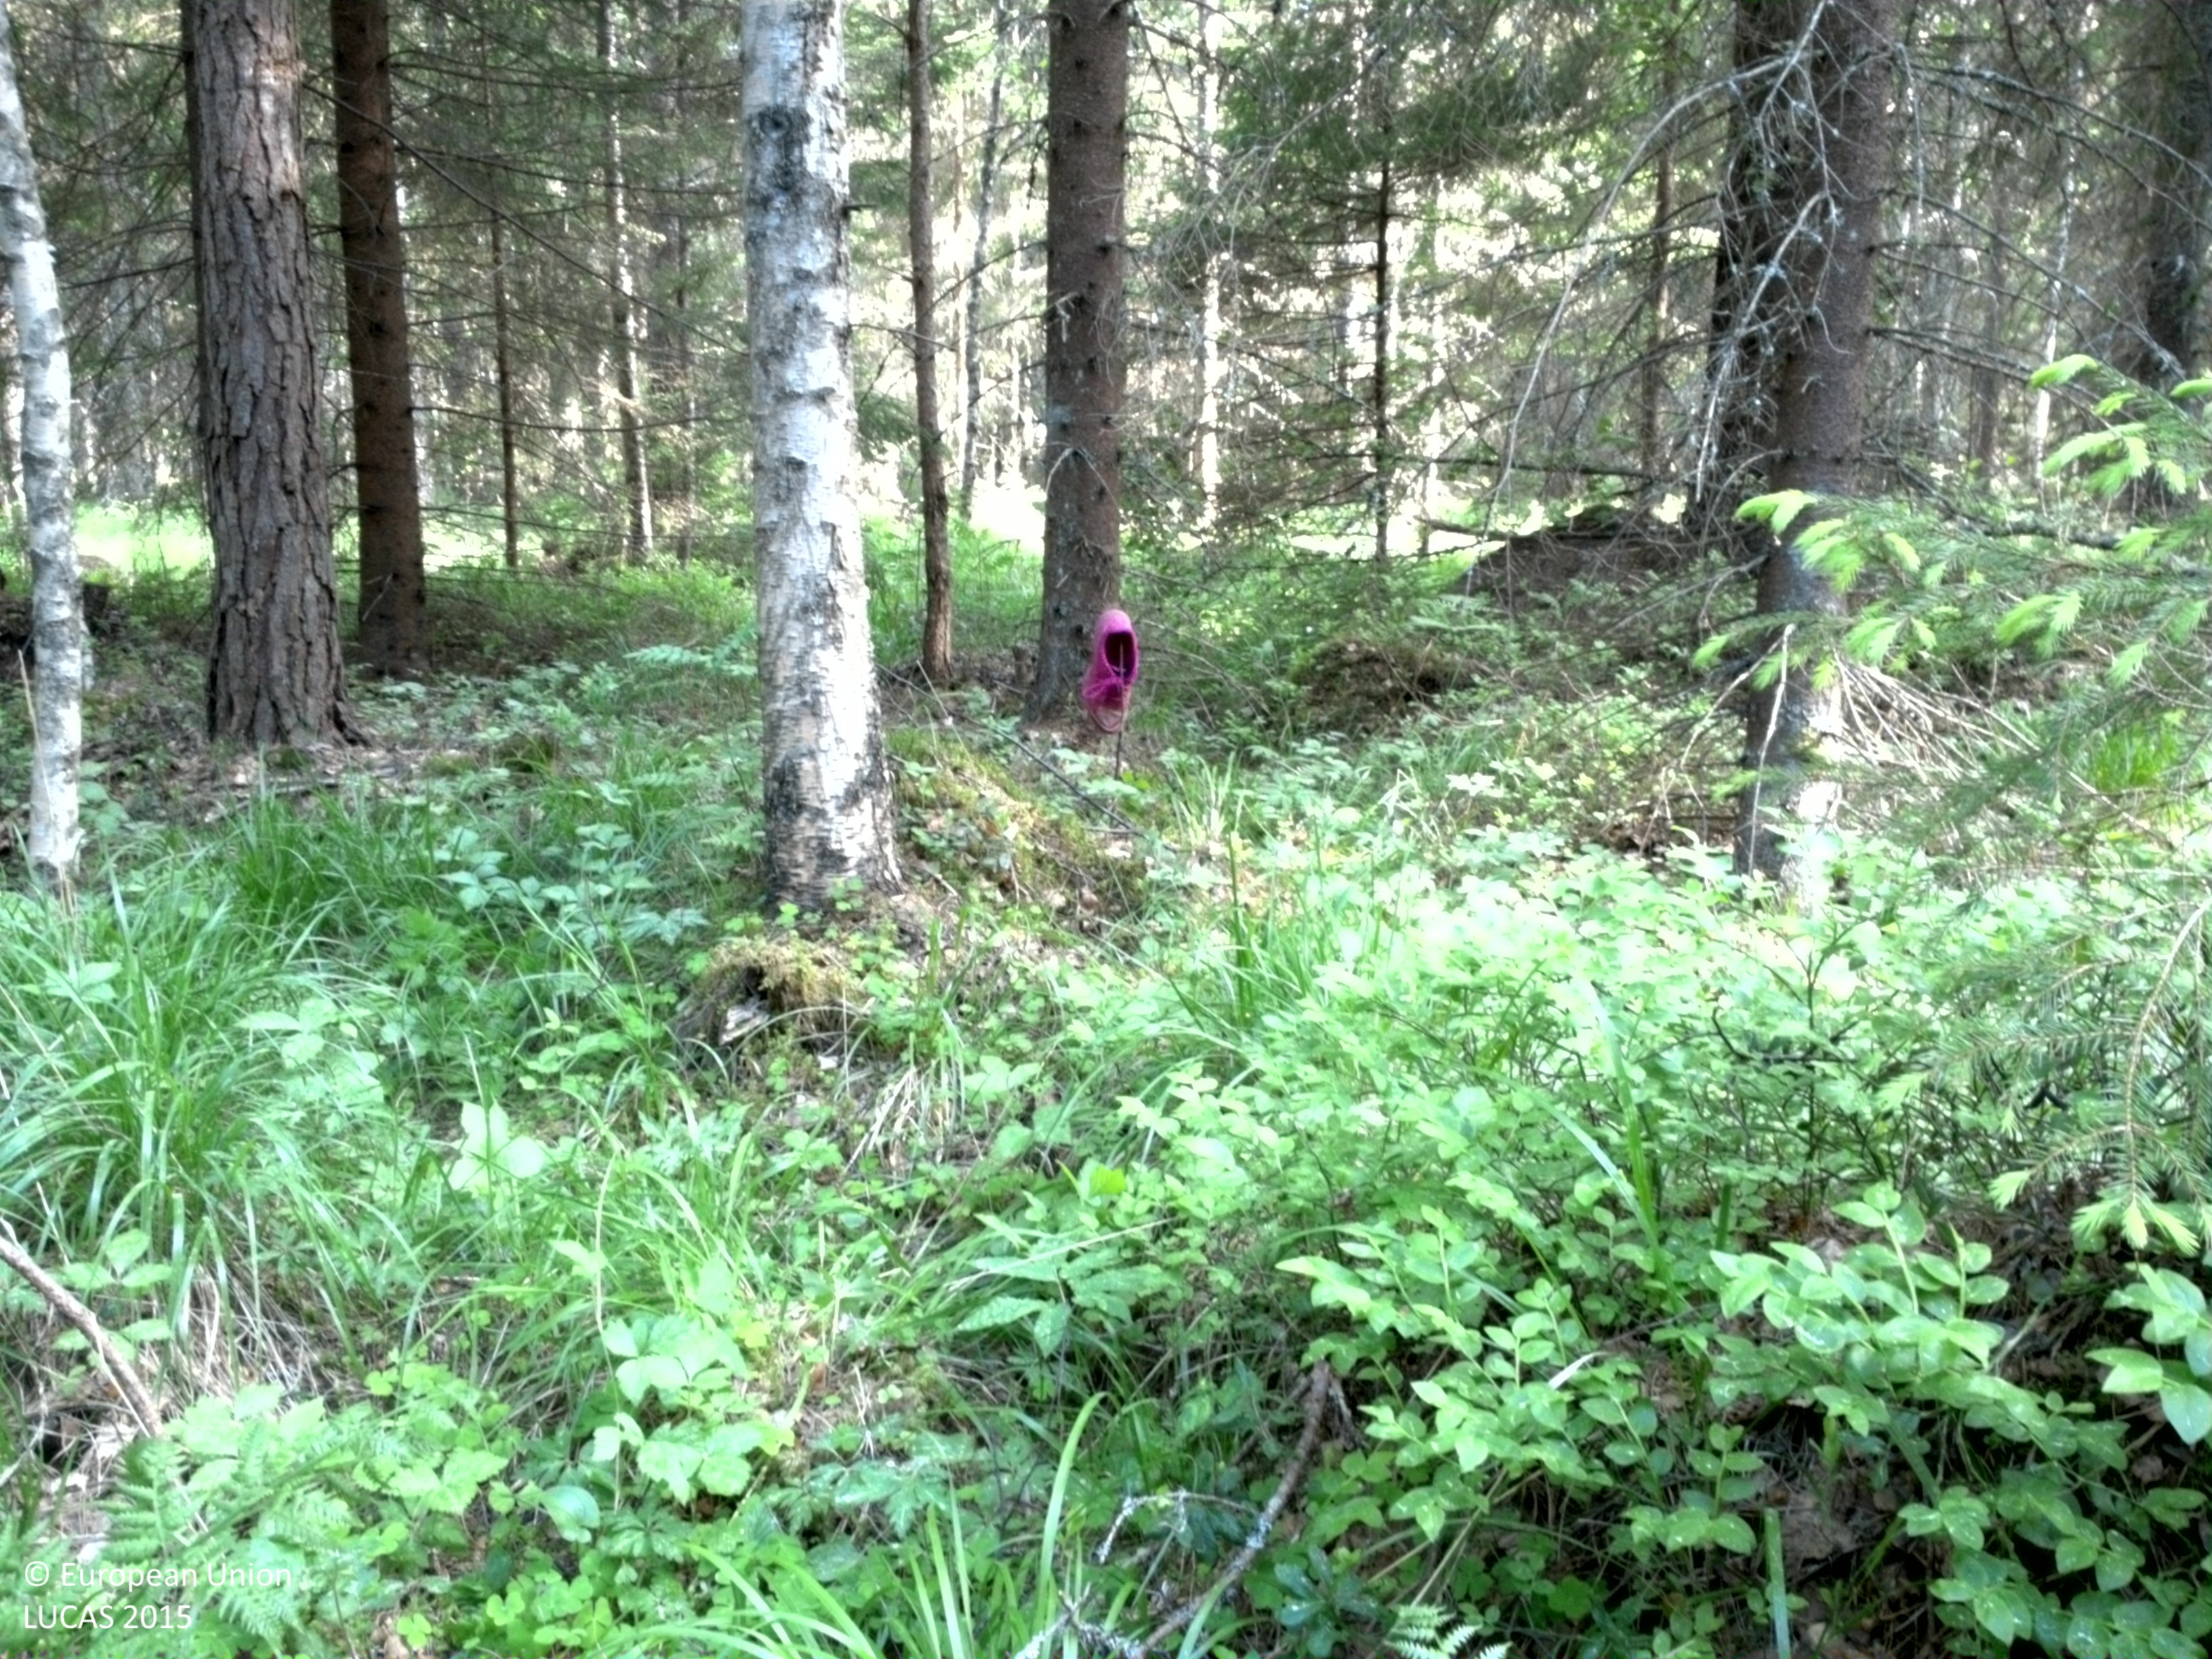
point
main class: Woodland
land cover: Pine dominated coniferous woodland
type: boreal forest
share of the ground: > 75 %
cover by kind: coniferous forest trees 85 %, broadleaved forest trees 5 %, herbaceous plants 5 %, lichens and mosses 5 %
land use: Forestry
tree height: > 5 m
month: June
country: SE
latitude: 60.0115
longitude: 18.8422
